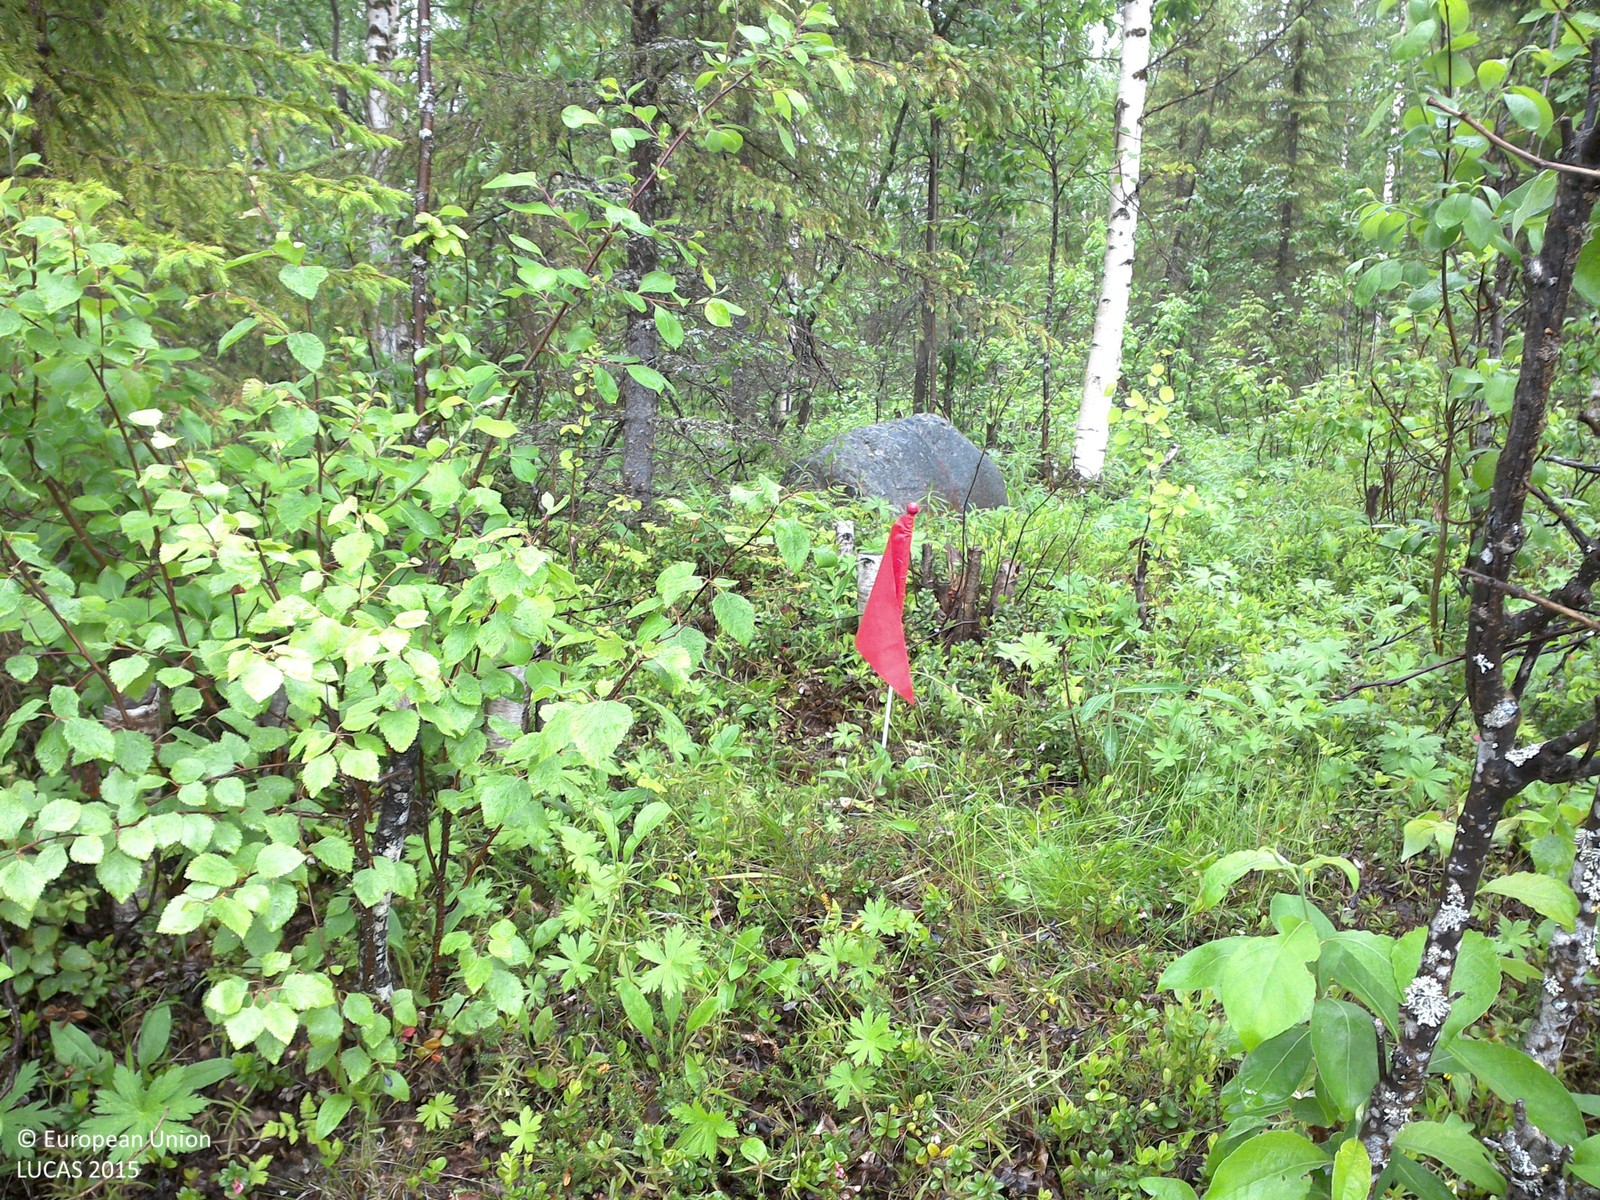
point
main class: Woodland
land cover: Other mixed woodland
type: boreal forest
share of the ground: 25 - 50 %
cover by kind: shrubs 55 %, broadleaved forest trees 20 %, herbaceous plants 15 %, coniferous forest trees 10 %
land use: Forestry
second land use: Amenities, museums, leisure
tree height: > 5 m
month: July
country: SE
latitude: 66.6643
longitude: 23.3499
